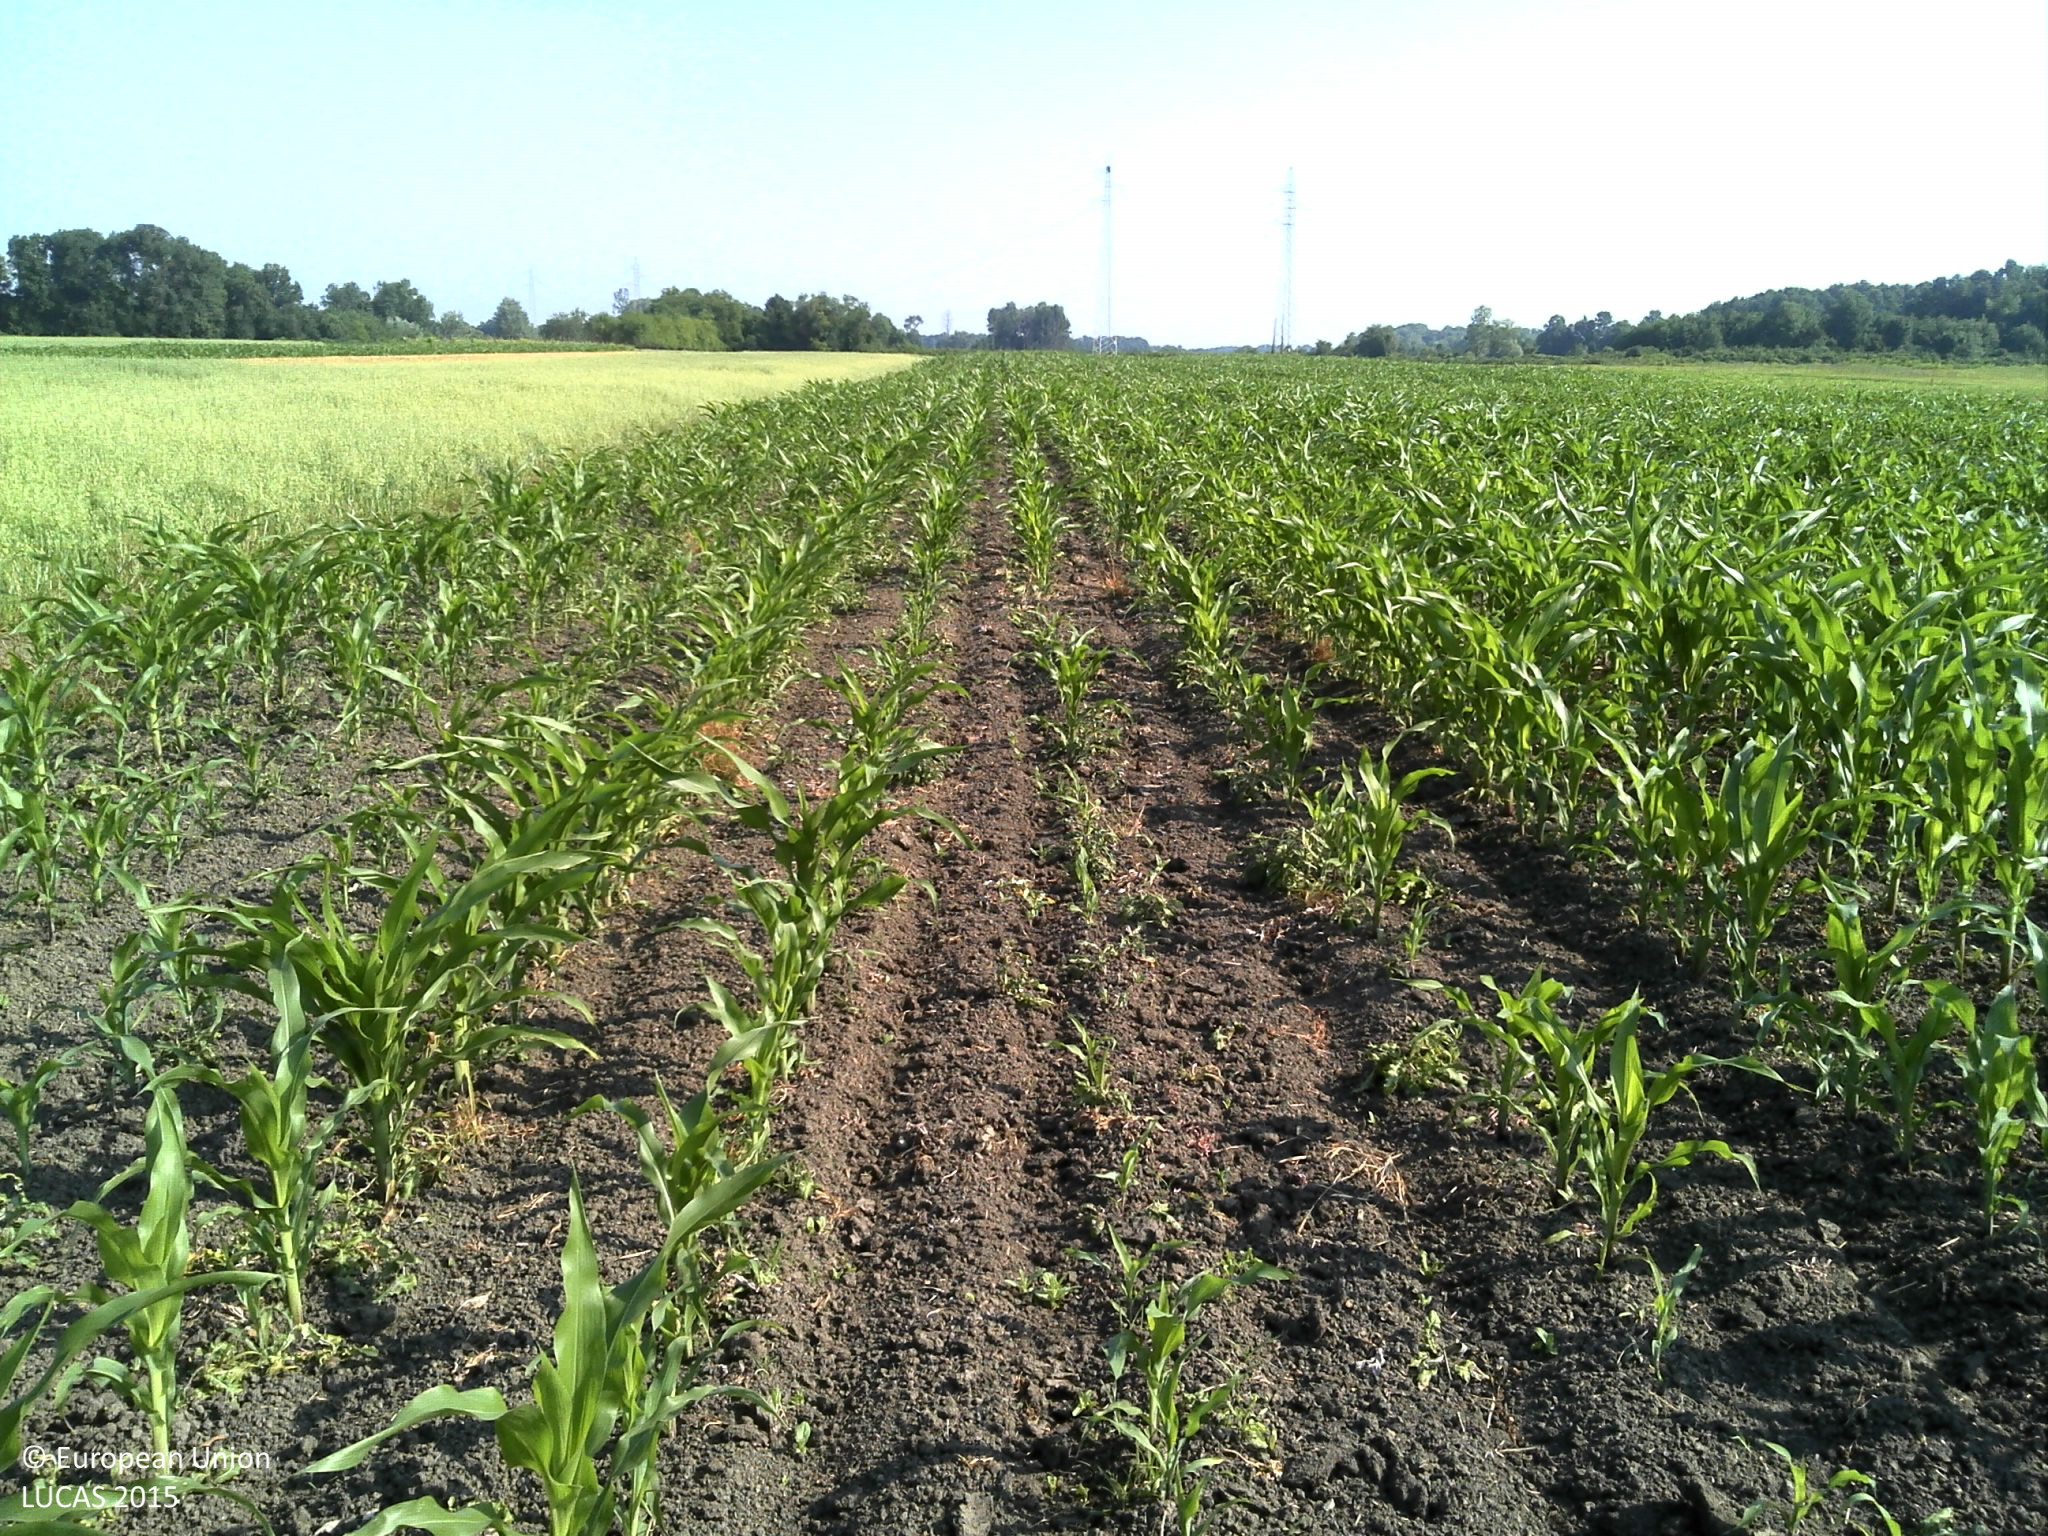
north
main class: Cropland
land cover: Maize
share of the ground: 25 - 50 %
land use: Agriculture (excluding fallow land and kitchen gardens)
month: June
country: HR
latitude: 45.2376
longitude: 18.4507
